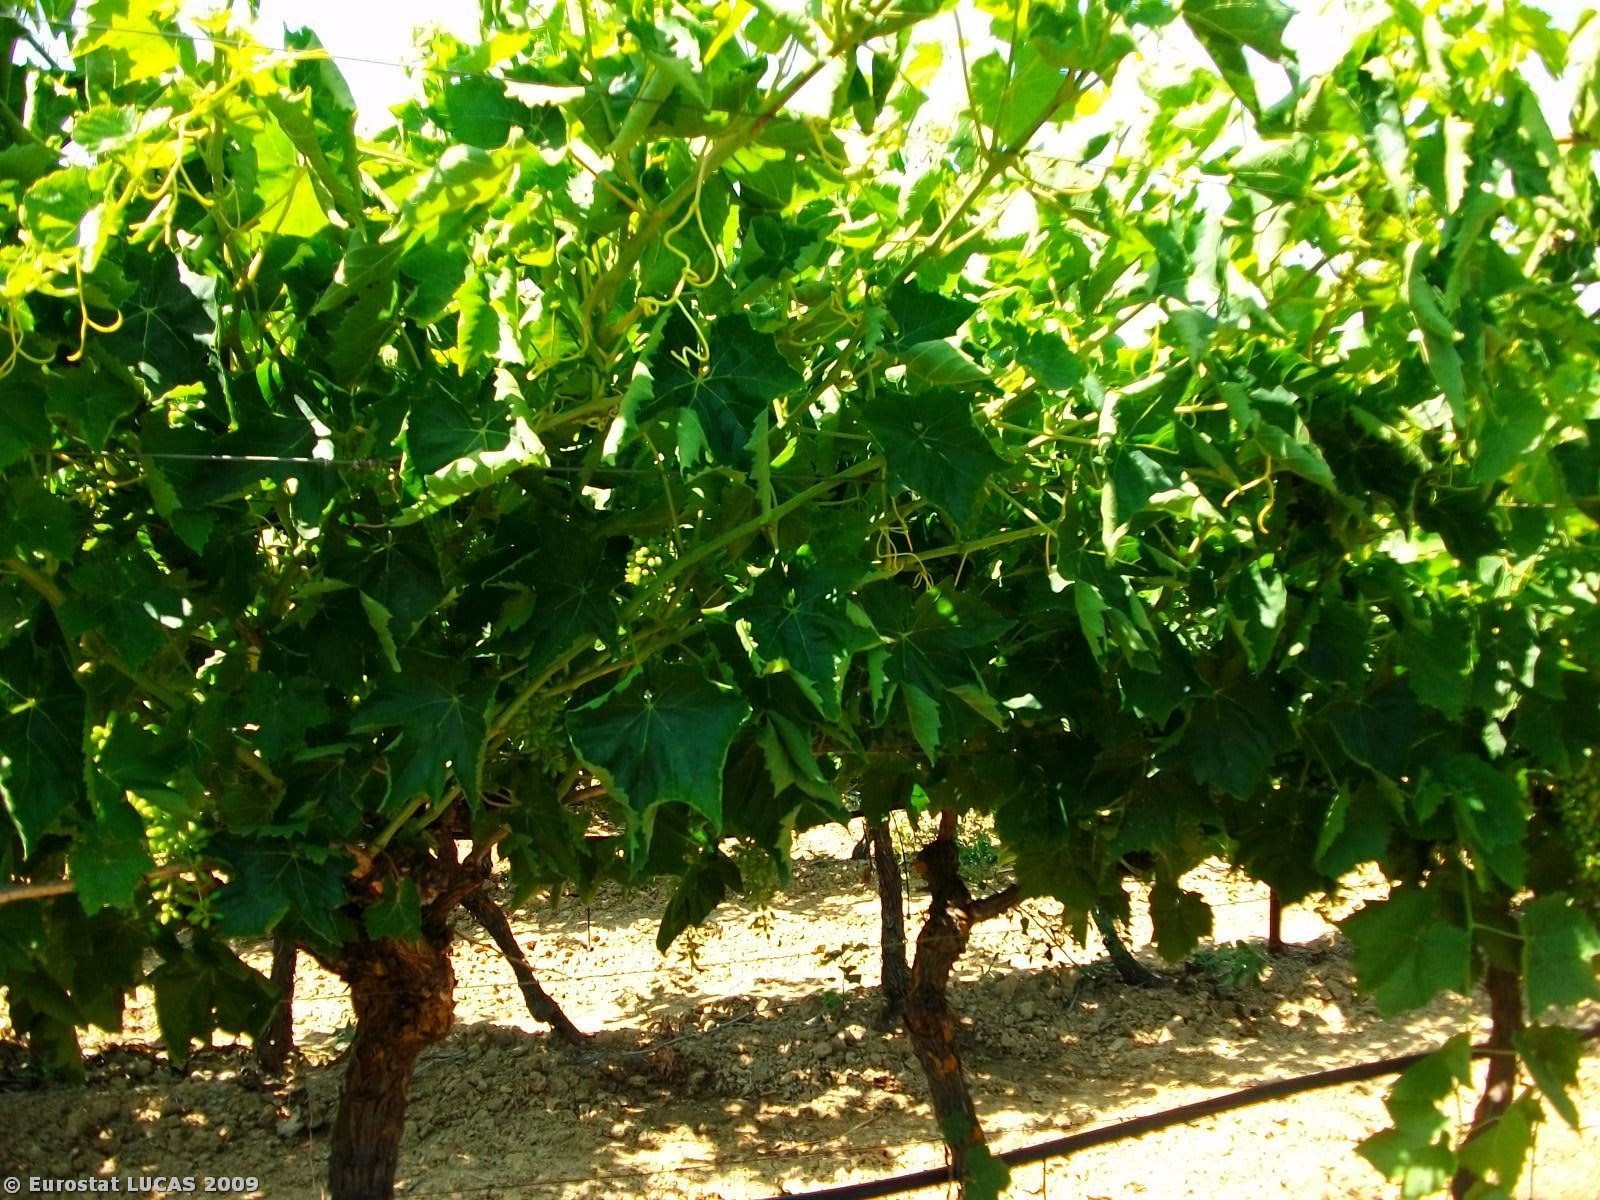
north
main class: Cropland
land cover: Vineyards
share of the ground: > 75 %
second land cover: Bare land
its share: > 75 %
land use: Agriculture (excluding fallow land and kitchen gardens)
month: June
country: GR
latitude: 35.0230
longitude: 25.1001
